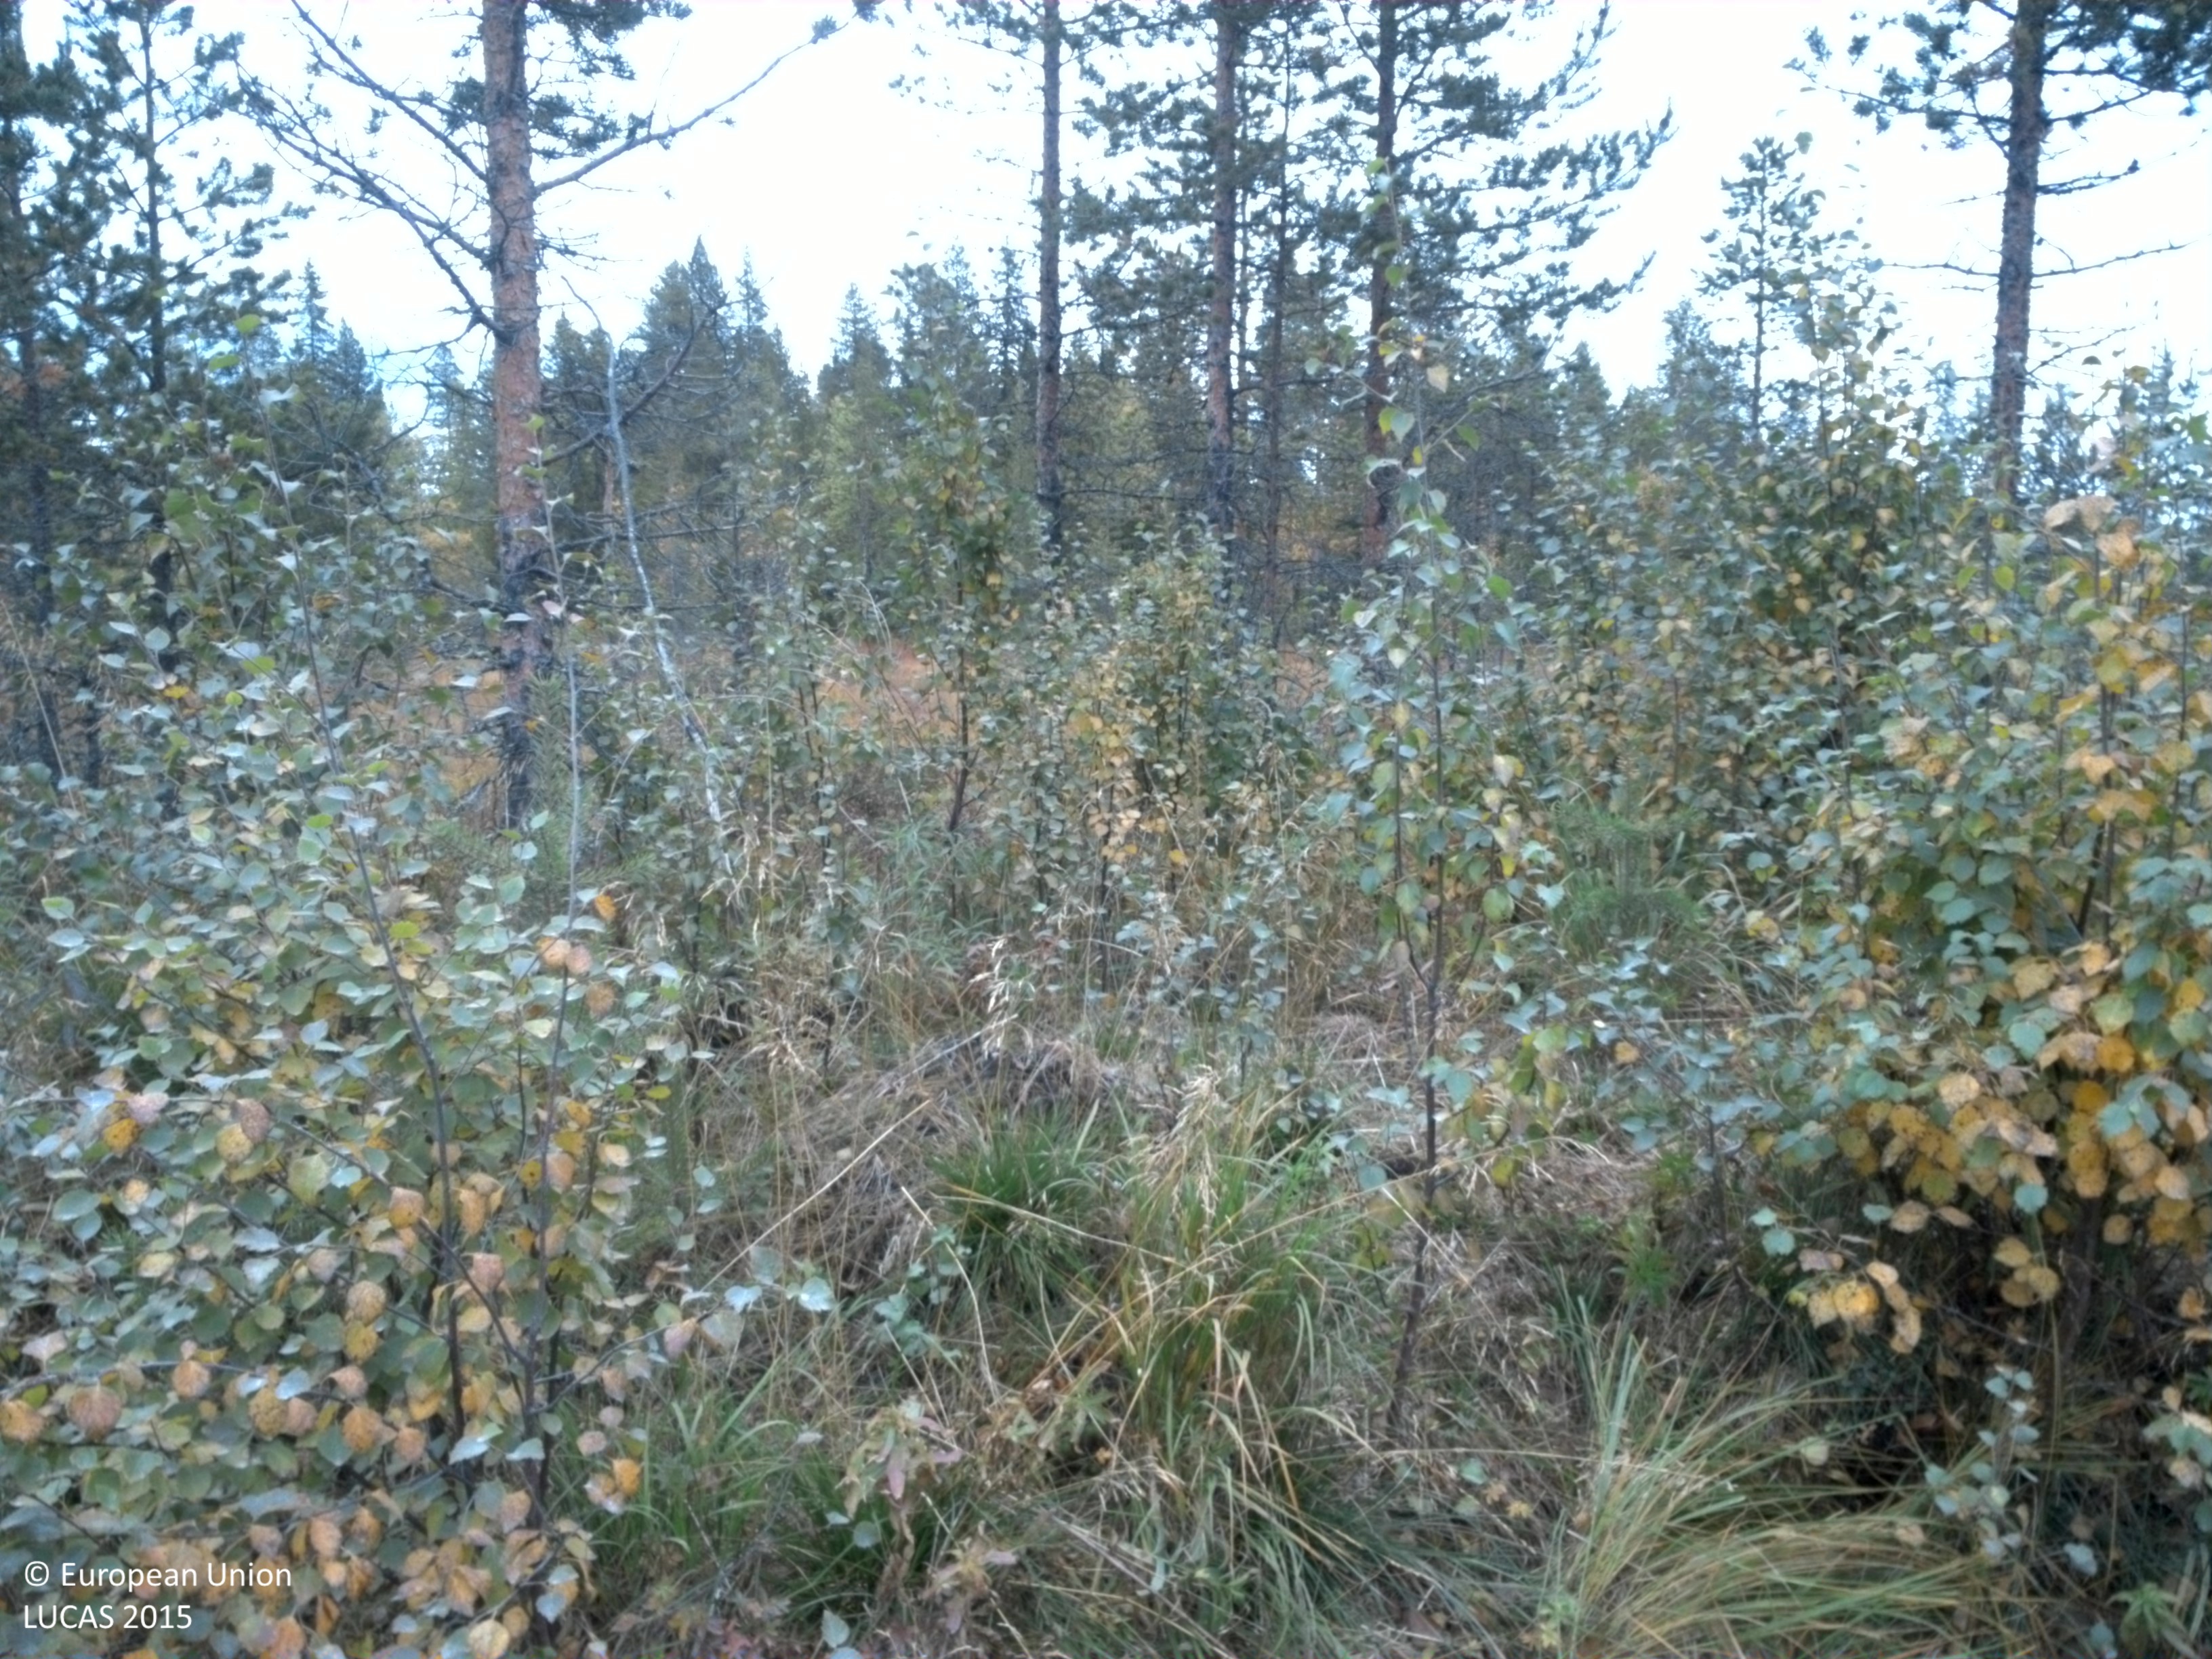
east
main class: Woodland
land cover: Broadleaved woodland
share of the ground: 25 - 50 %
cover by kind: herbaceous plants 60 %, broadleaved forest trees 30 %, coniferous forest trees 5 %, unconsolidated bare surface 5 %
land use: Semi-natural and natural areas not in use
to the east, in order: Ditches and canals; Broadleaved woodland; Pine dominated coniferous woodland; Shrubland with sparse tree cover; Peatbogs; Shrubland with sparse tree cover; Other mixed woodland; Spruce dominated mixed woodland; Other mixed woodland
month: September
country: SE
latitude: 65.1751
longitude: 16.8578
